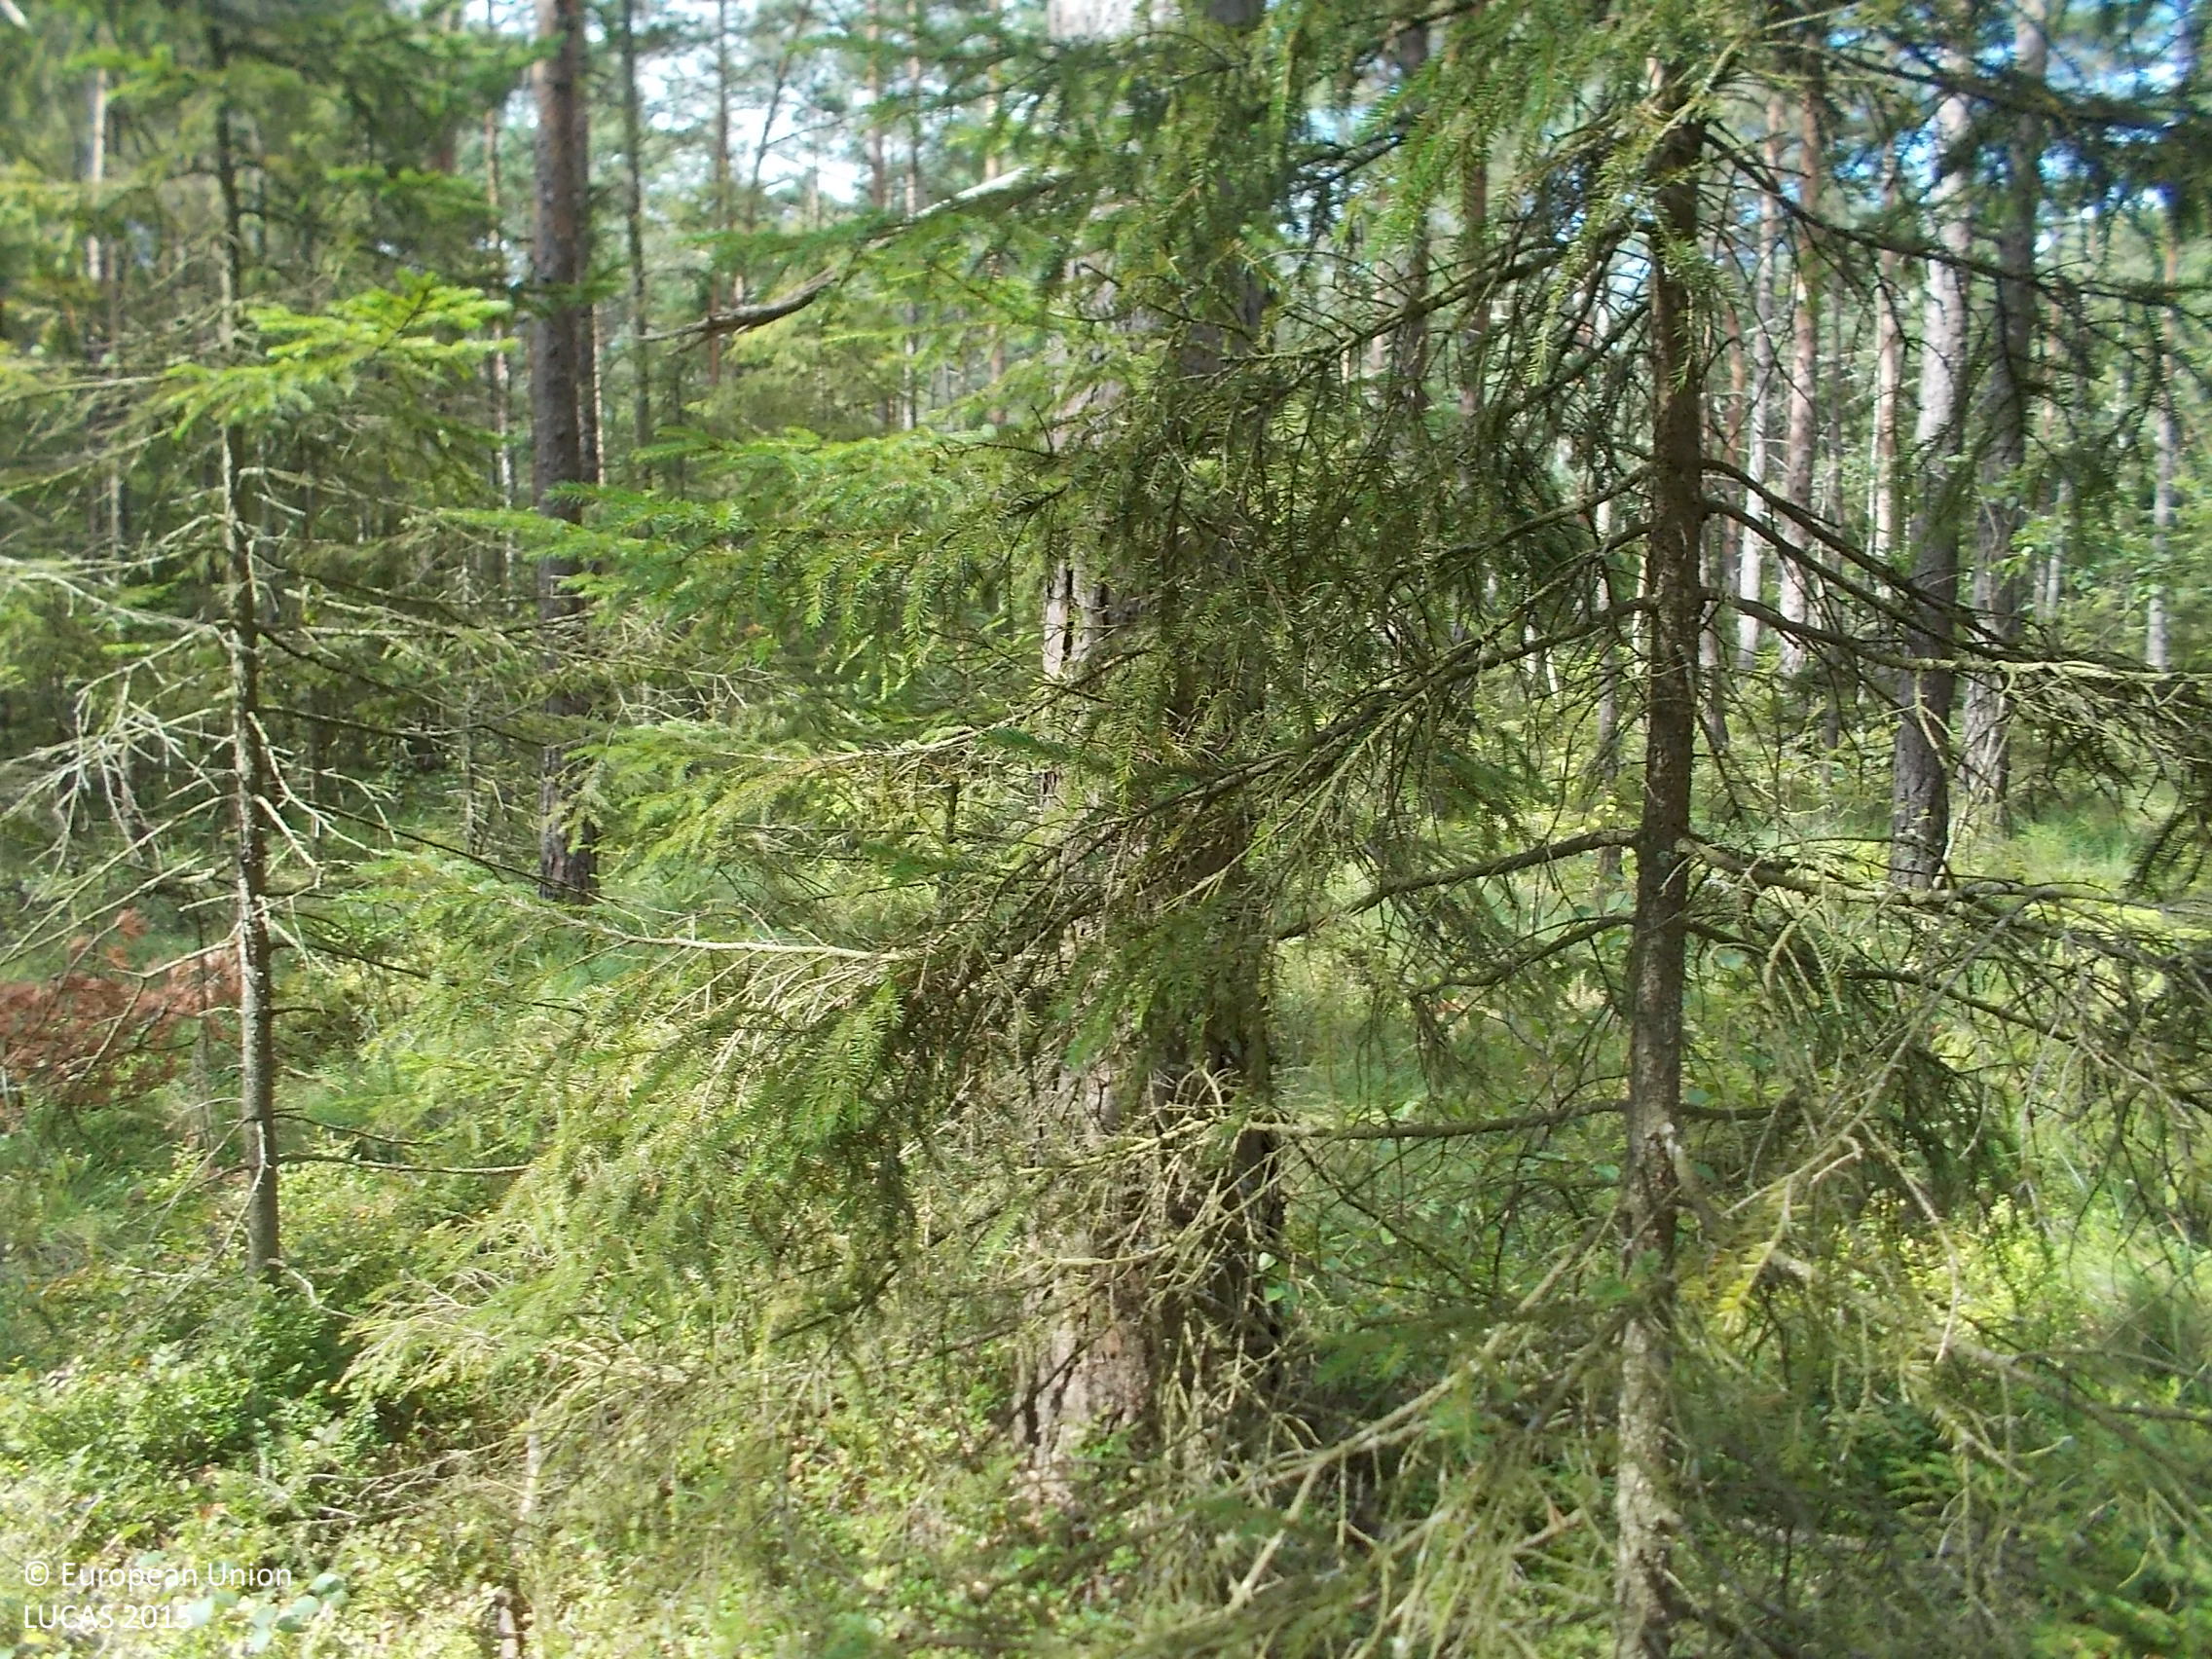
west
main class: Woodland
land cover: Pine dominated coniferous woodland
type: boreal forest
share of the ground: > 75 %
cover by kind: coniferous forest trees 85 %, shrubs 10 %, herbaceous plants 5 %
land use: Forestry
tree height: > 5 m
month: August
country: SE
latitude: 57.5883
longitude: 12.2881
